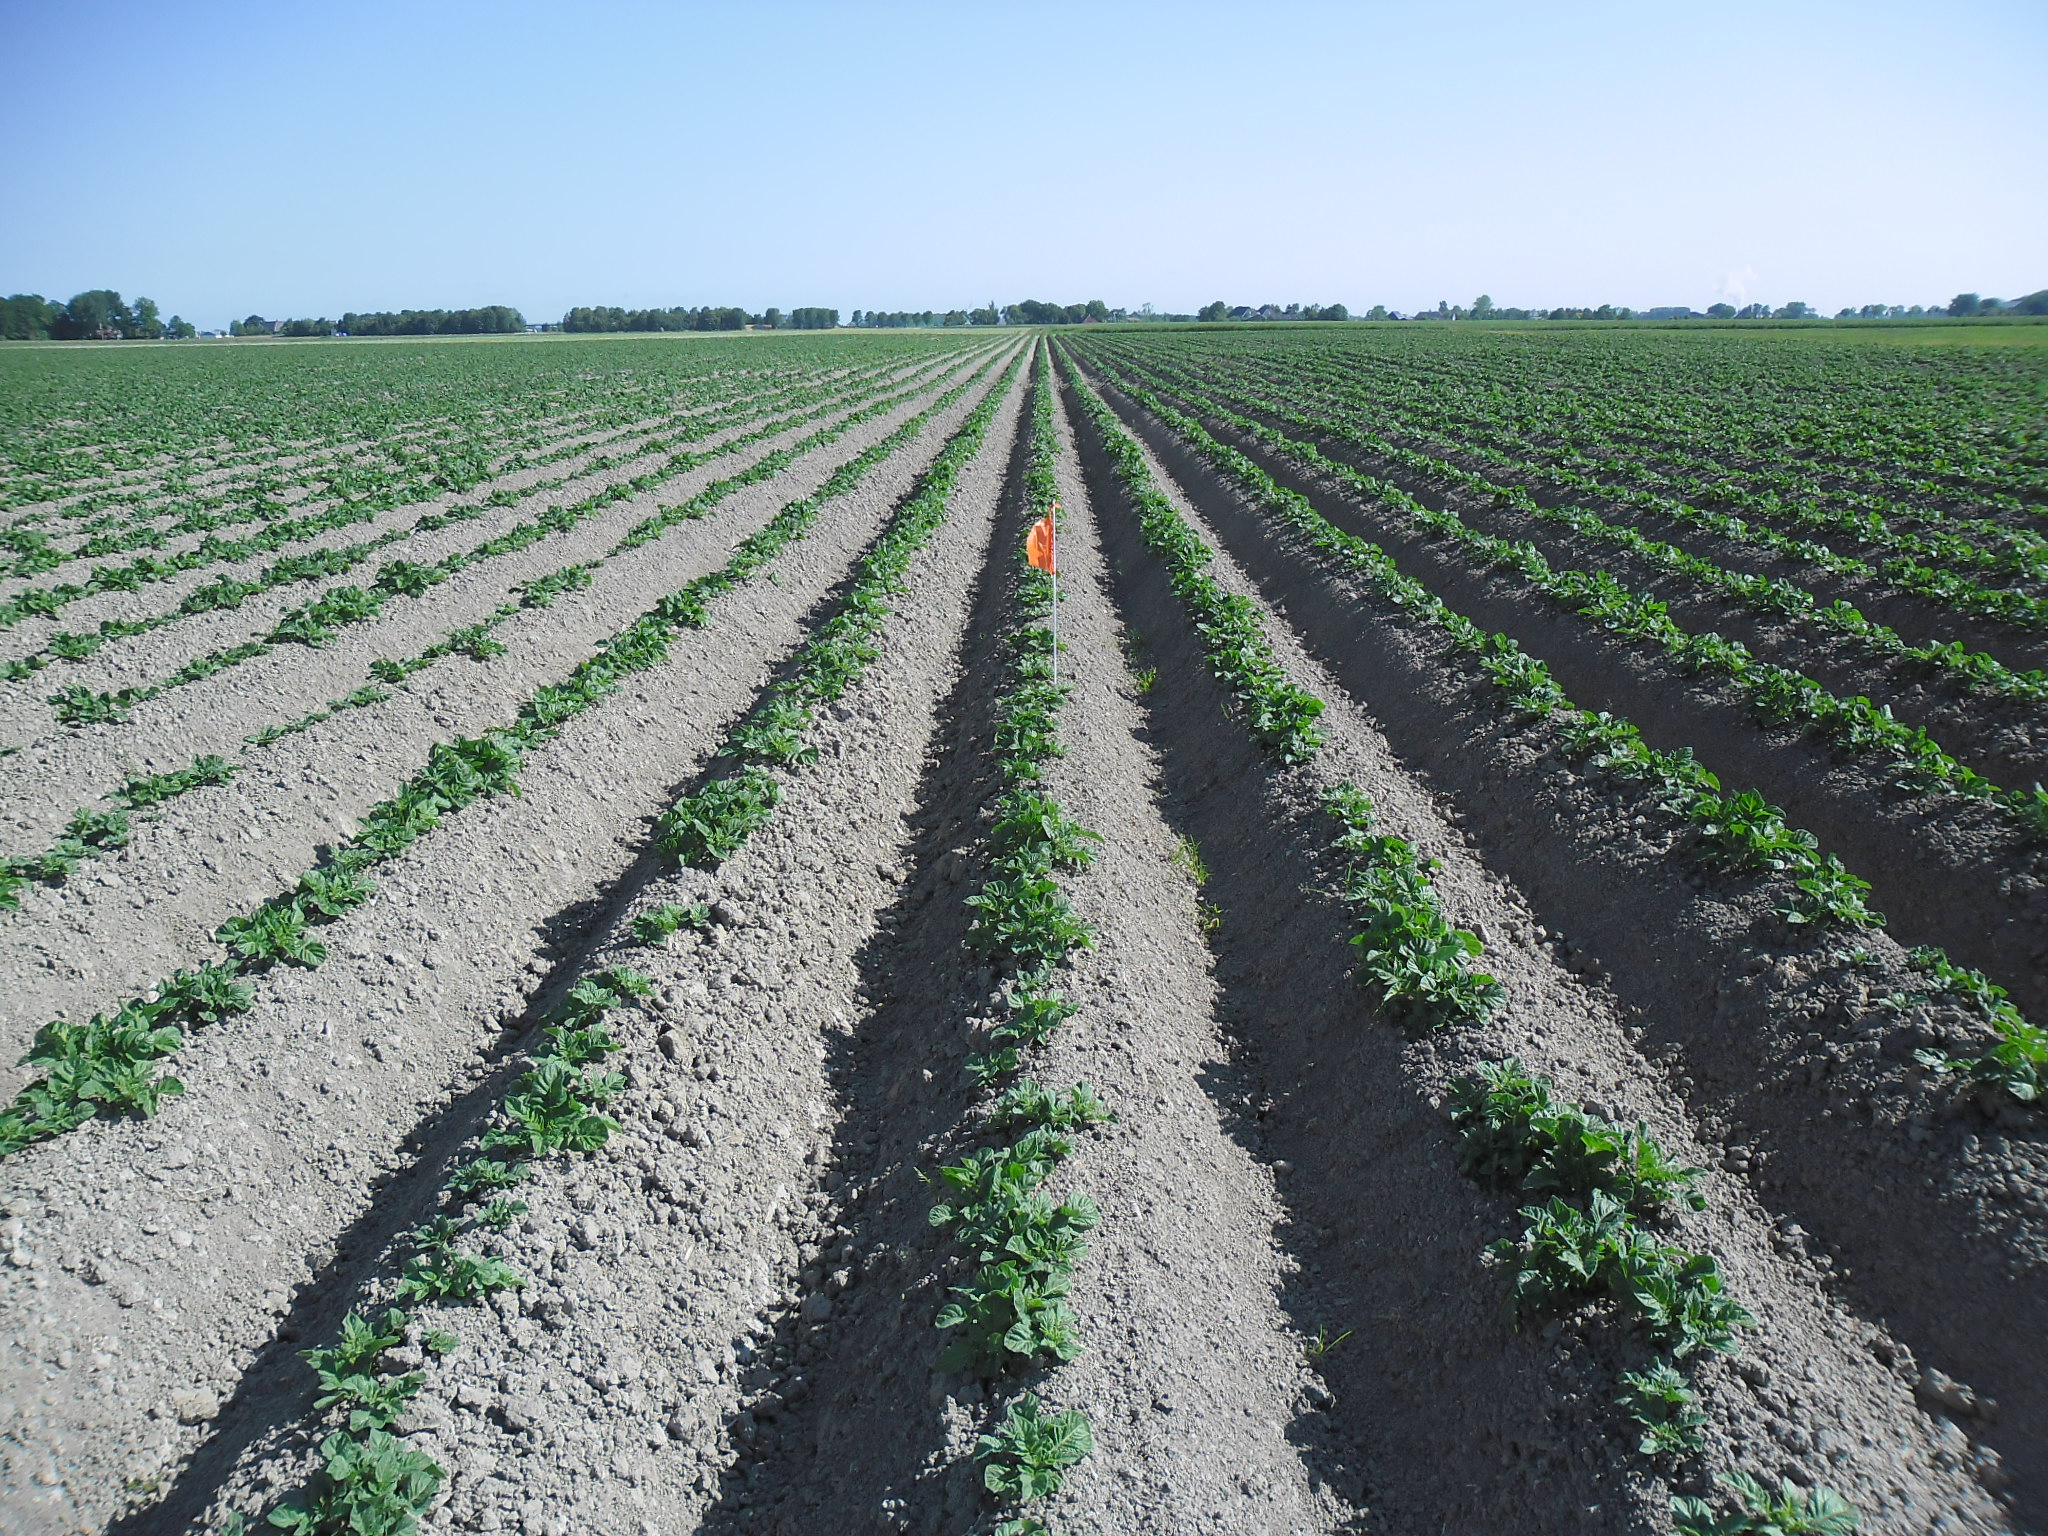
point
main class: Cropland
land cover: Potatoes
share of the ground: < 10 %
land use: Agriculture (excluding fallow land and kitchen gardens)
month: June
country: NL
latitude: 53.3385
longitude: 6.6812
